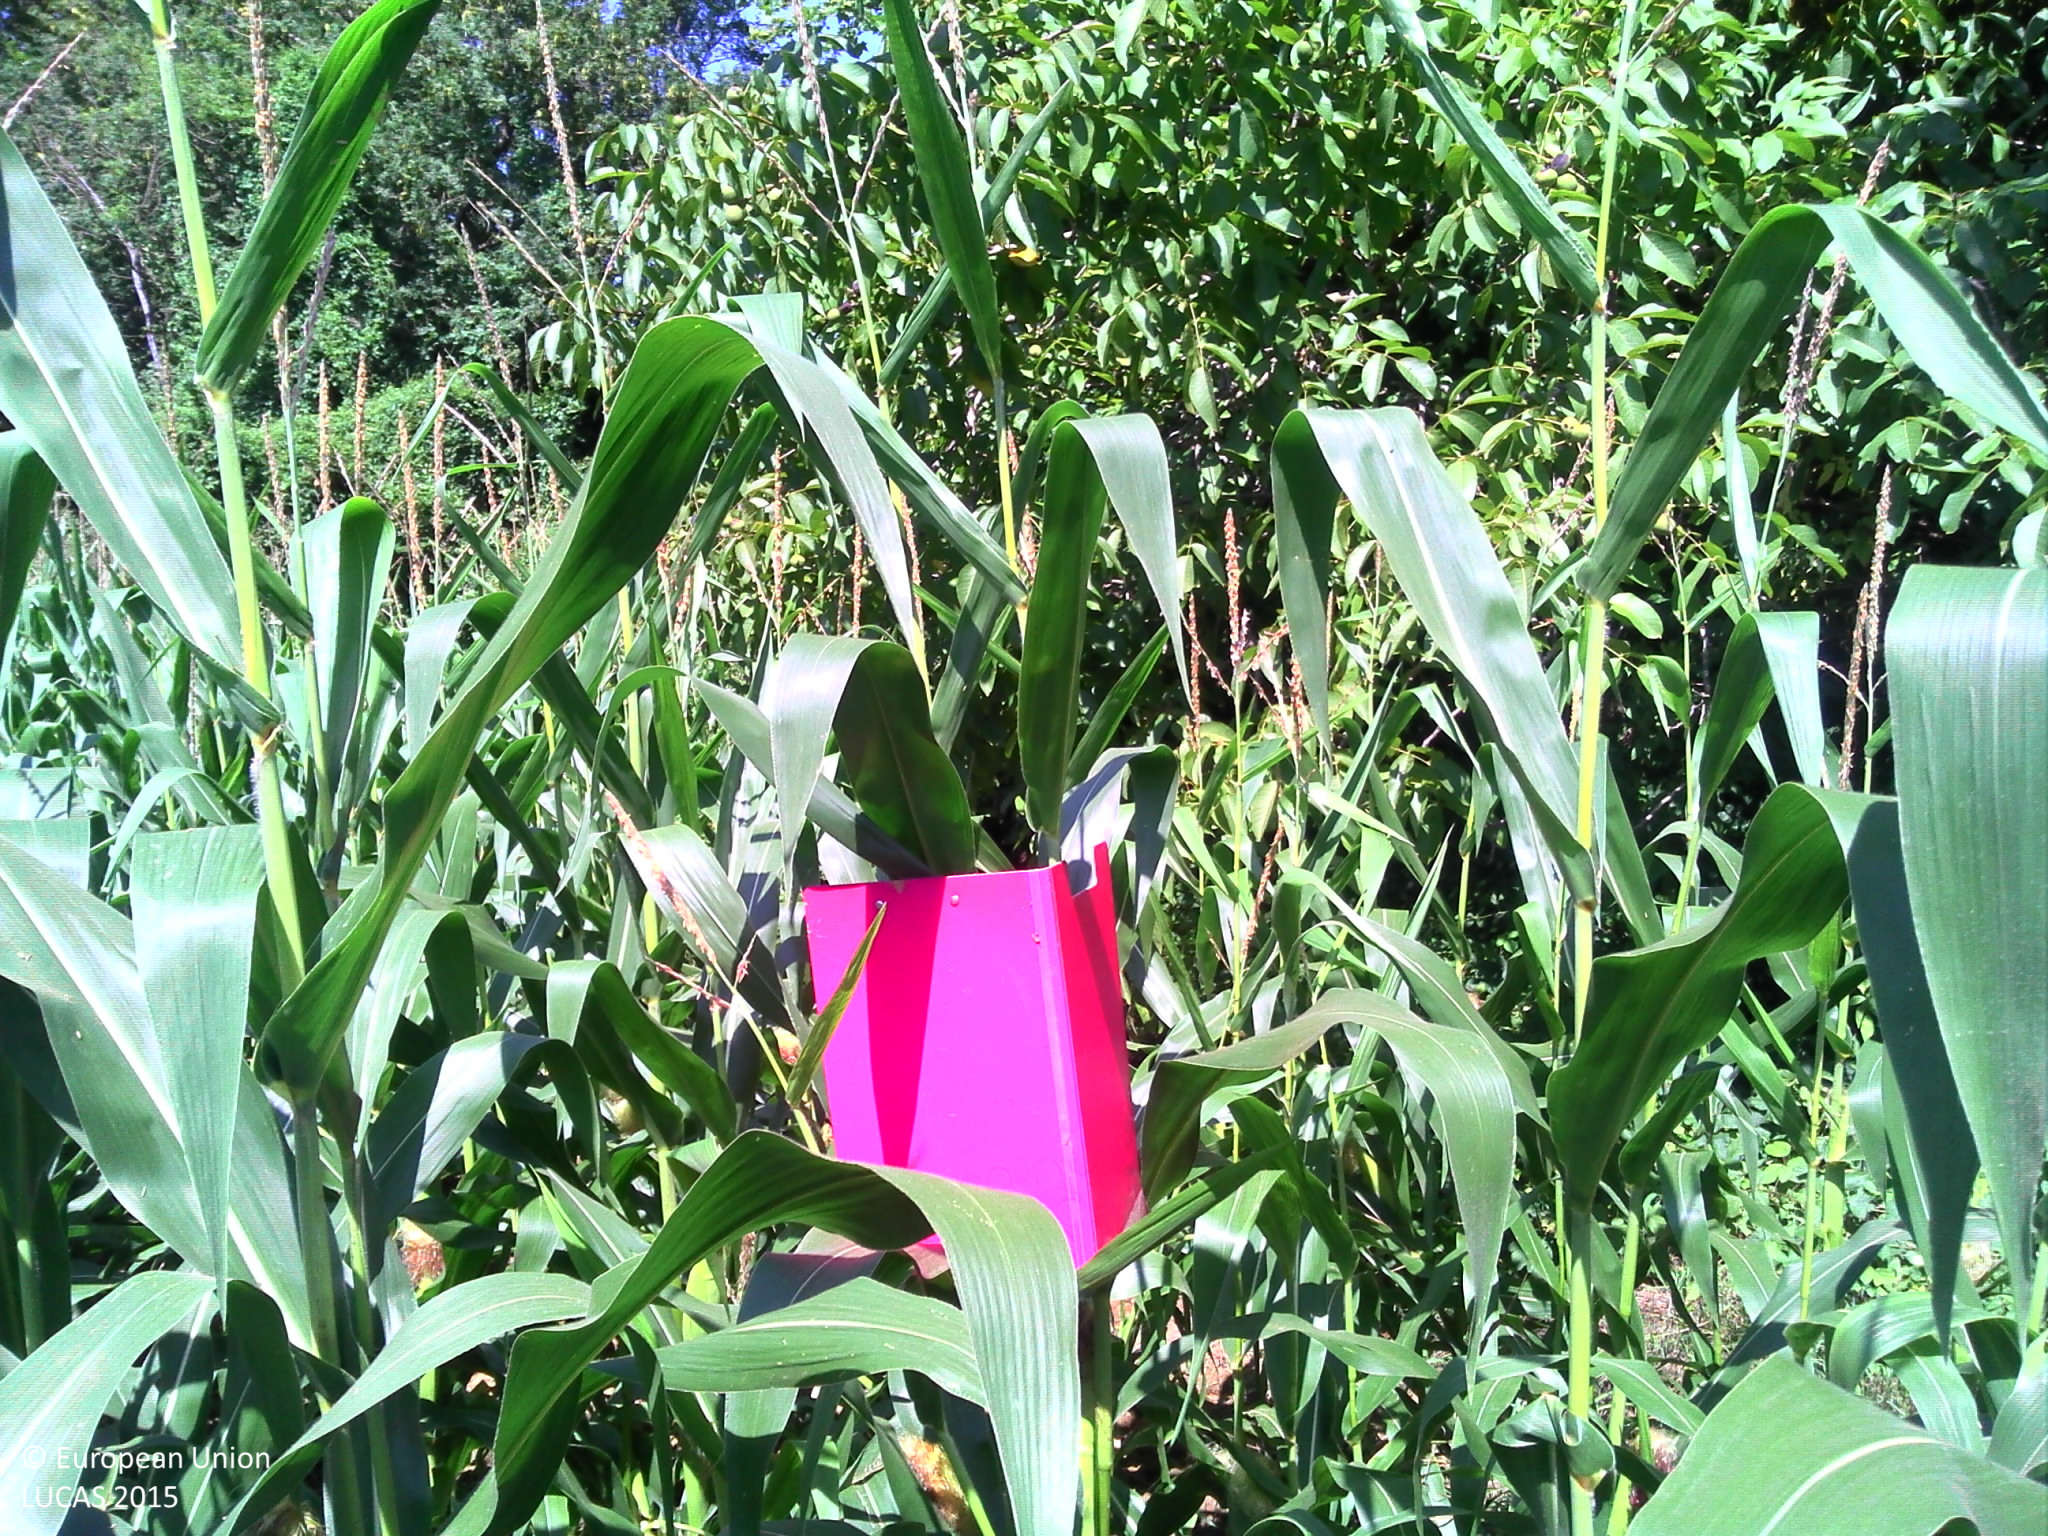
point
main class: Cropland
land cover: Maize
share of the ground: > 75 %
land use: Agriculture (excluding fallow land and kitchen gardens)
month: August
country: FR
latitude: 43.3220
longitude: -1.0493
